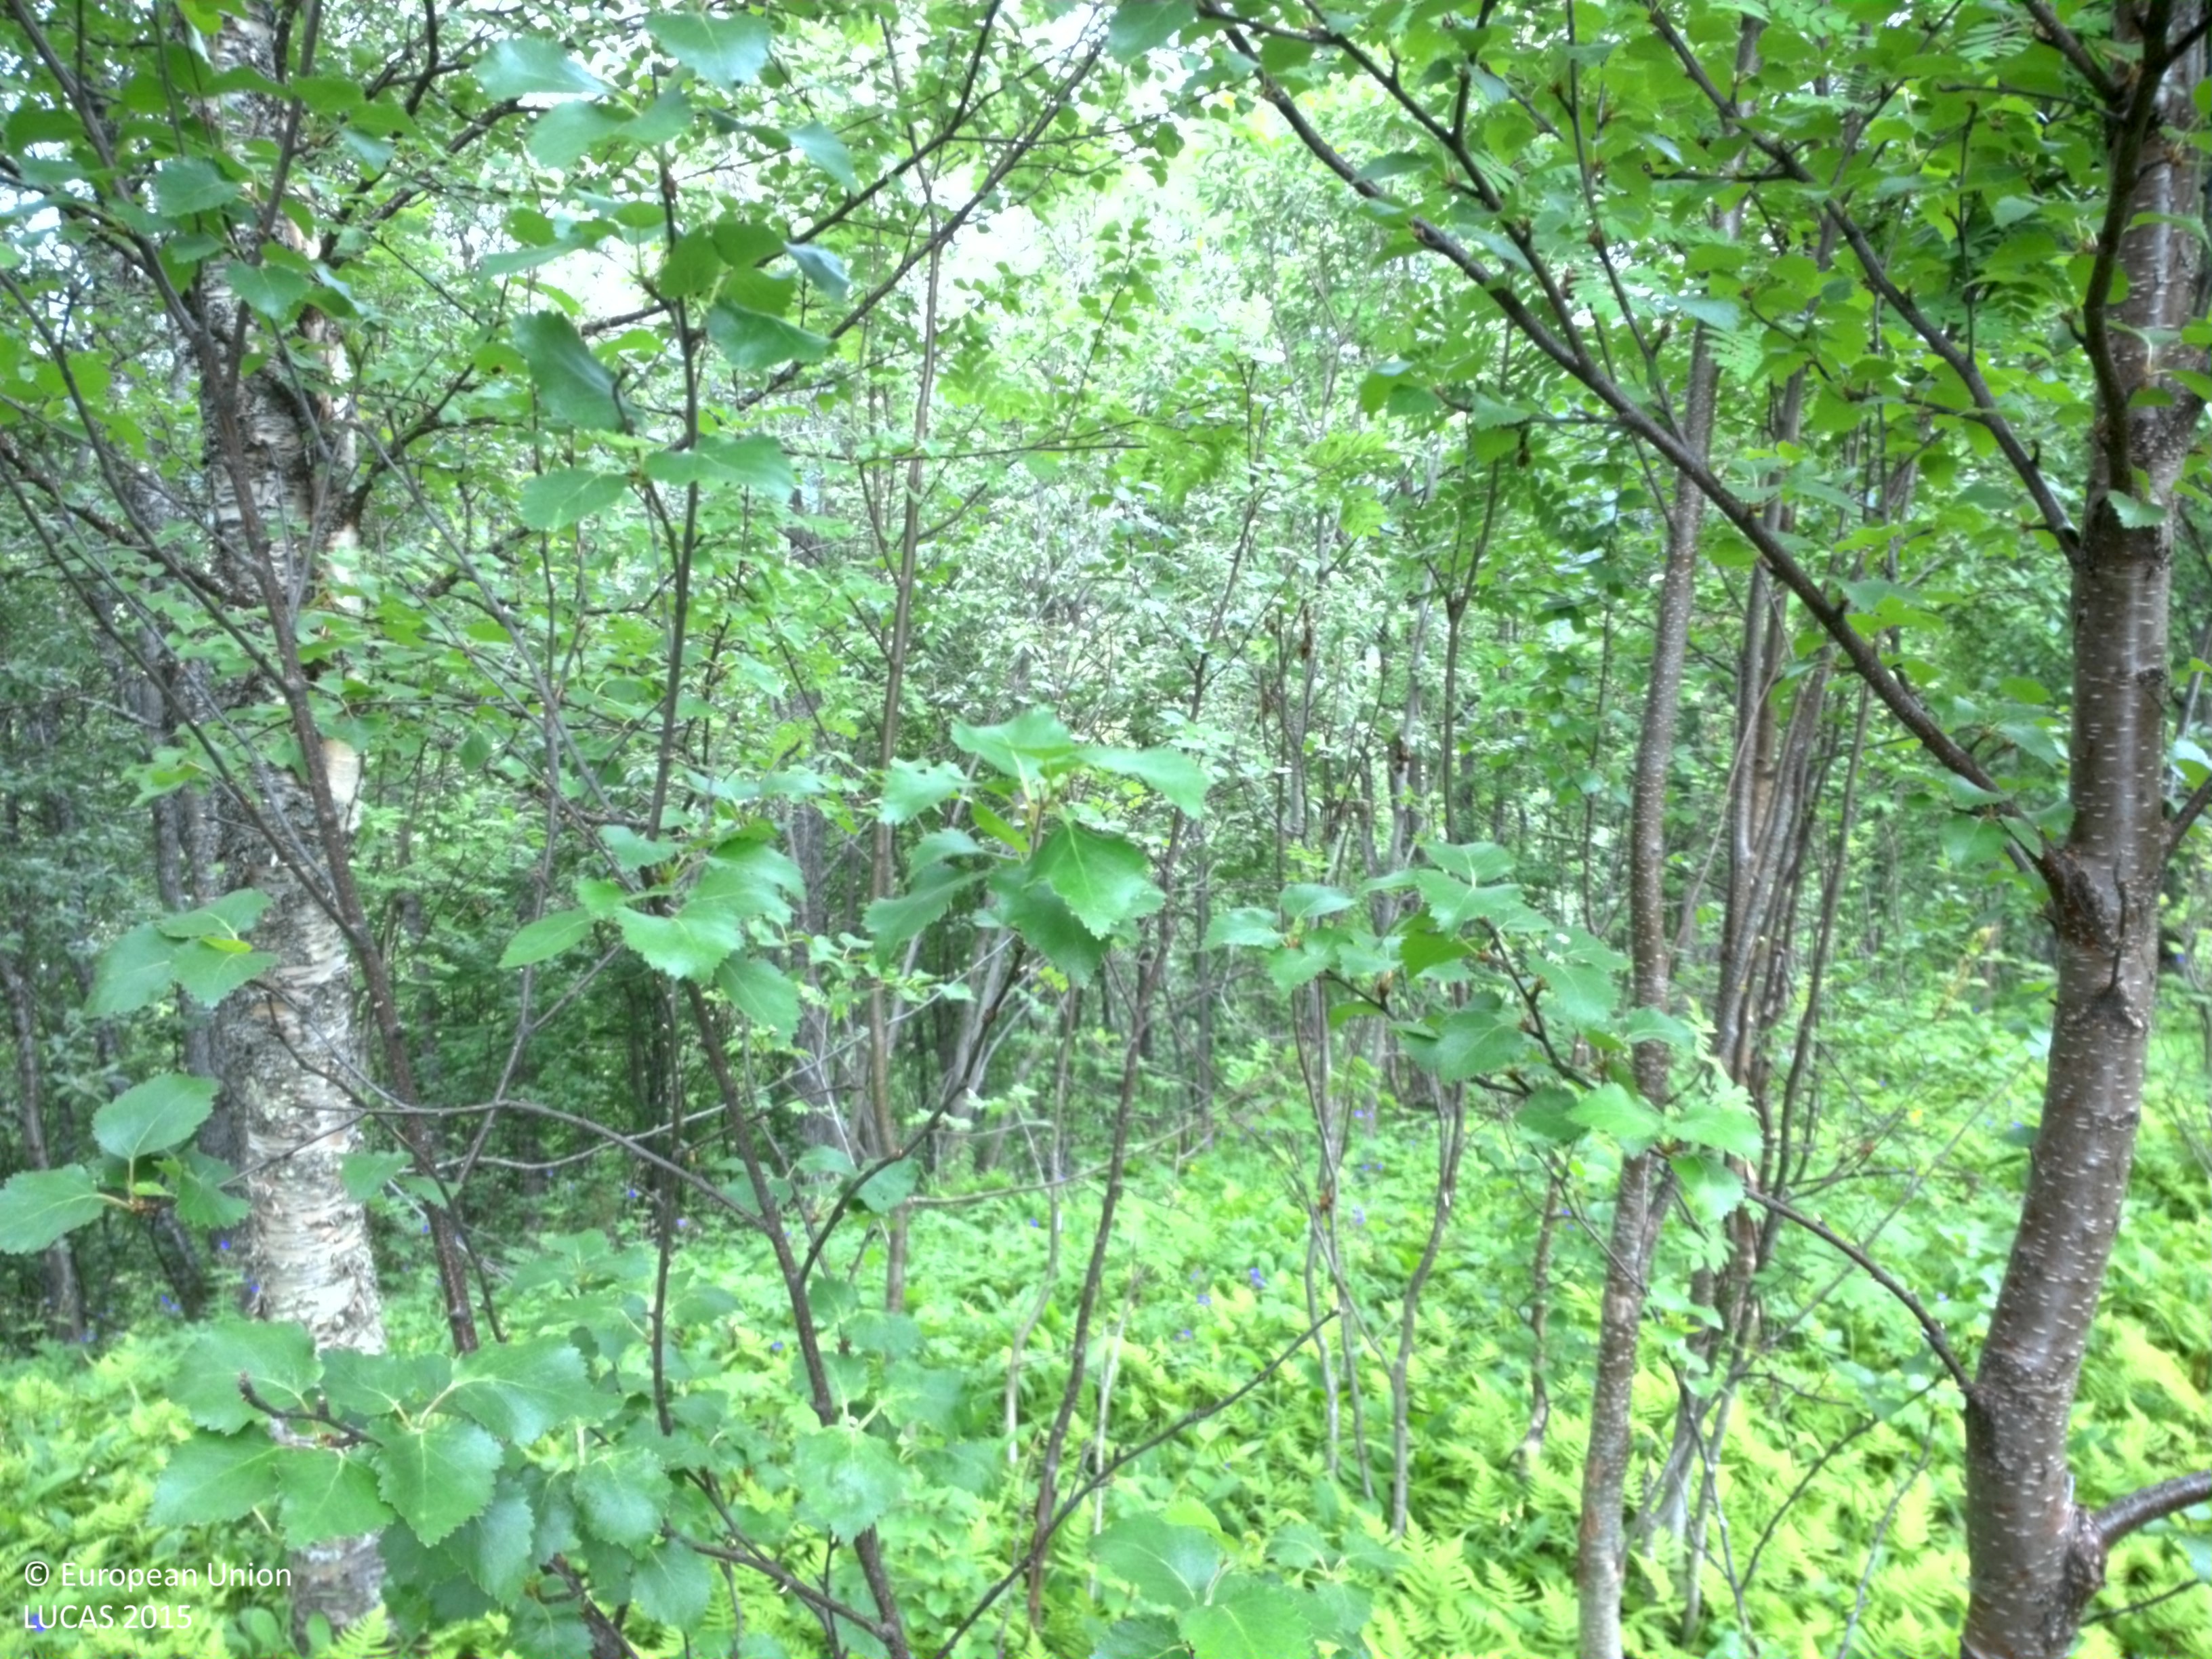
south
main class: Woodland
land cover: Broadleaved woodland
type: non-riverine alder, birch or aspen forest
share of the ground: 25 - 50 %
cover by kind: herbaceous plants 60 %, broadleaved forest trees 35 %, shrubs 5 %
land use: Amenities, museums, leisure
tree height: > 5 m
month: July
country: SE
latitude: 65.6718
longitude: 15.7277
